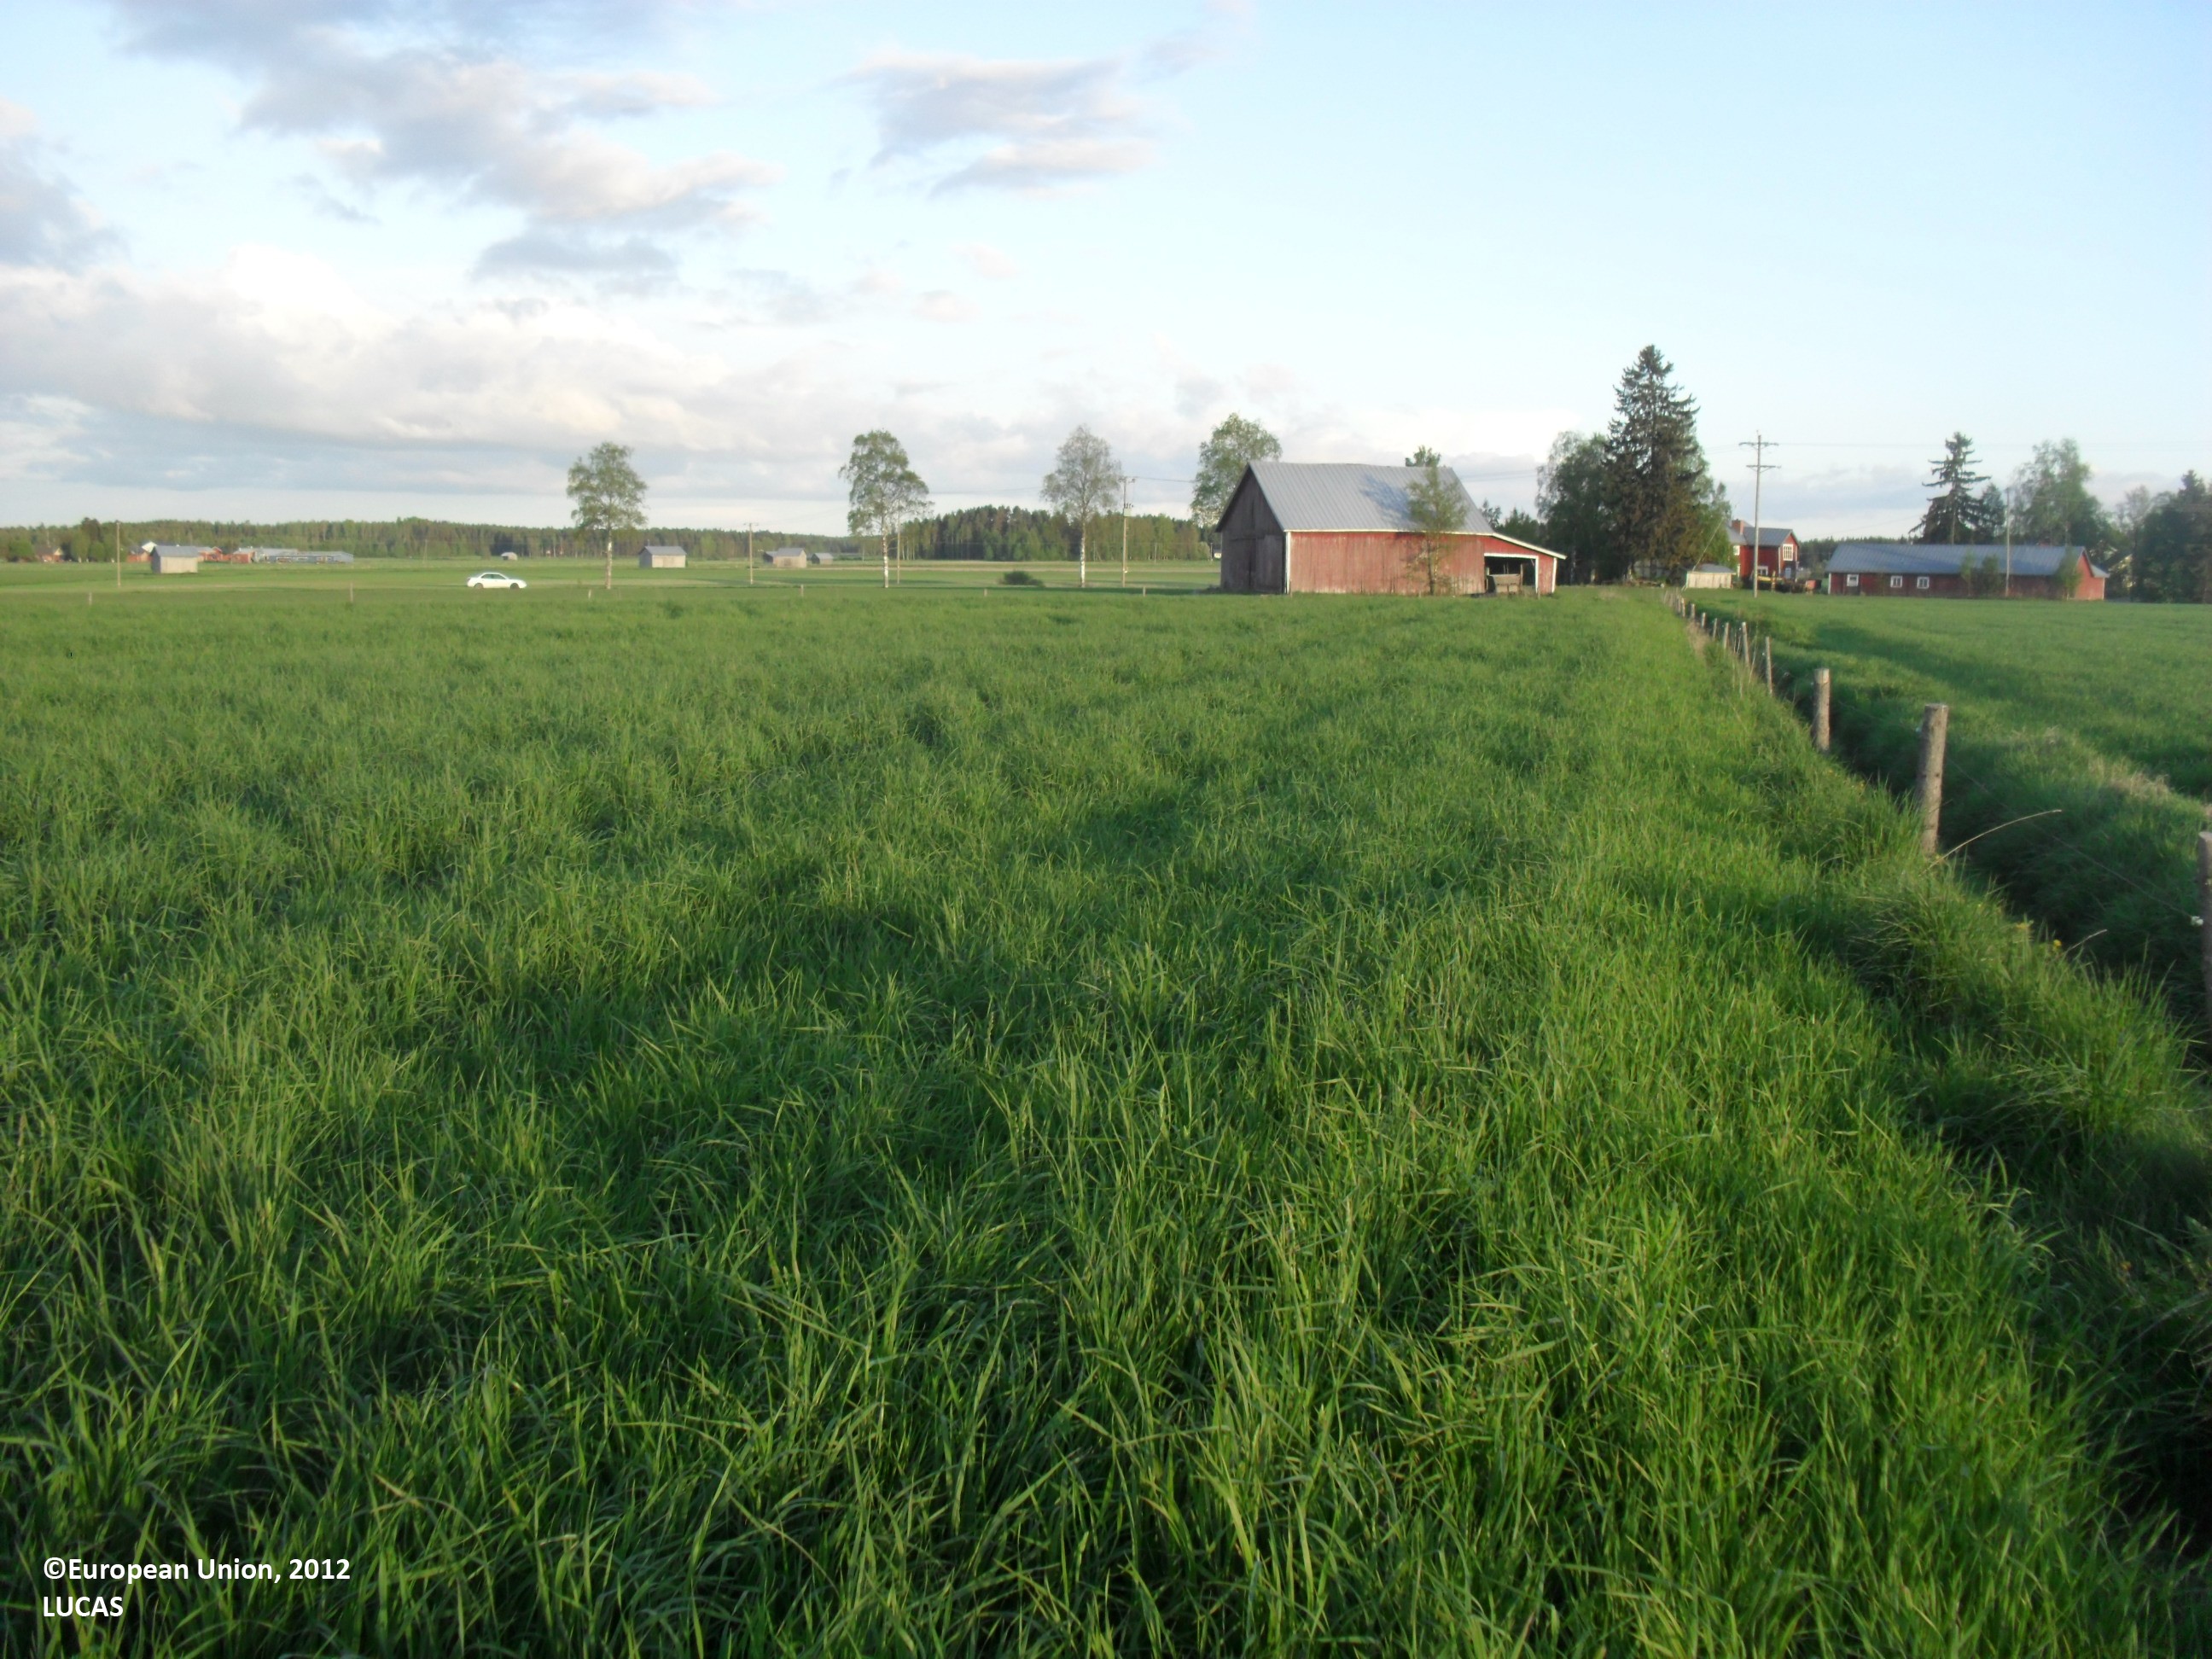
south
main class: Cropland
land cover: Temporary grasslands
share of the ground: > 75 %
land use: Agriculture (excluding fallow land and kitchen gardens)
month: June
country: FI
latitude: 62.9088
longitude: 23.1906
